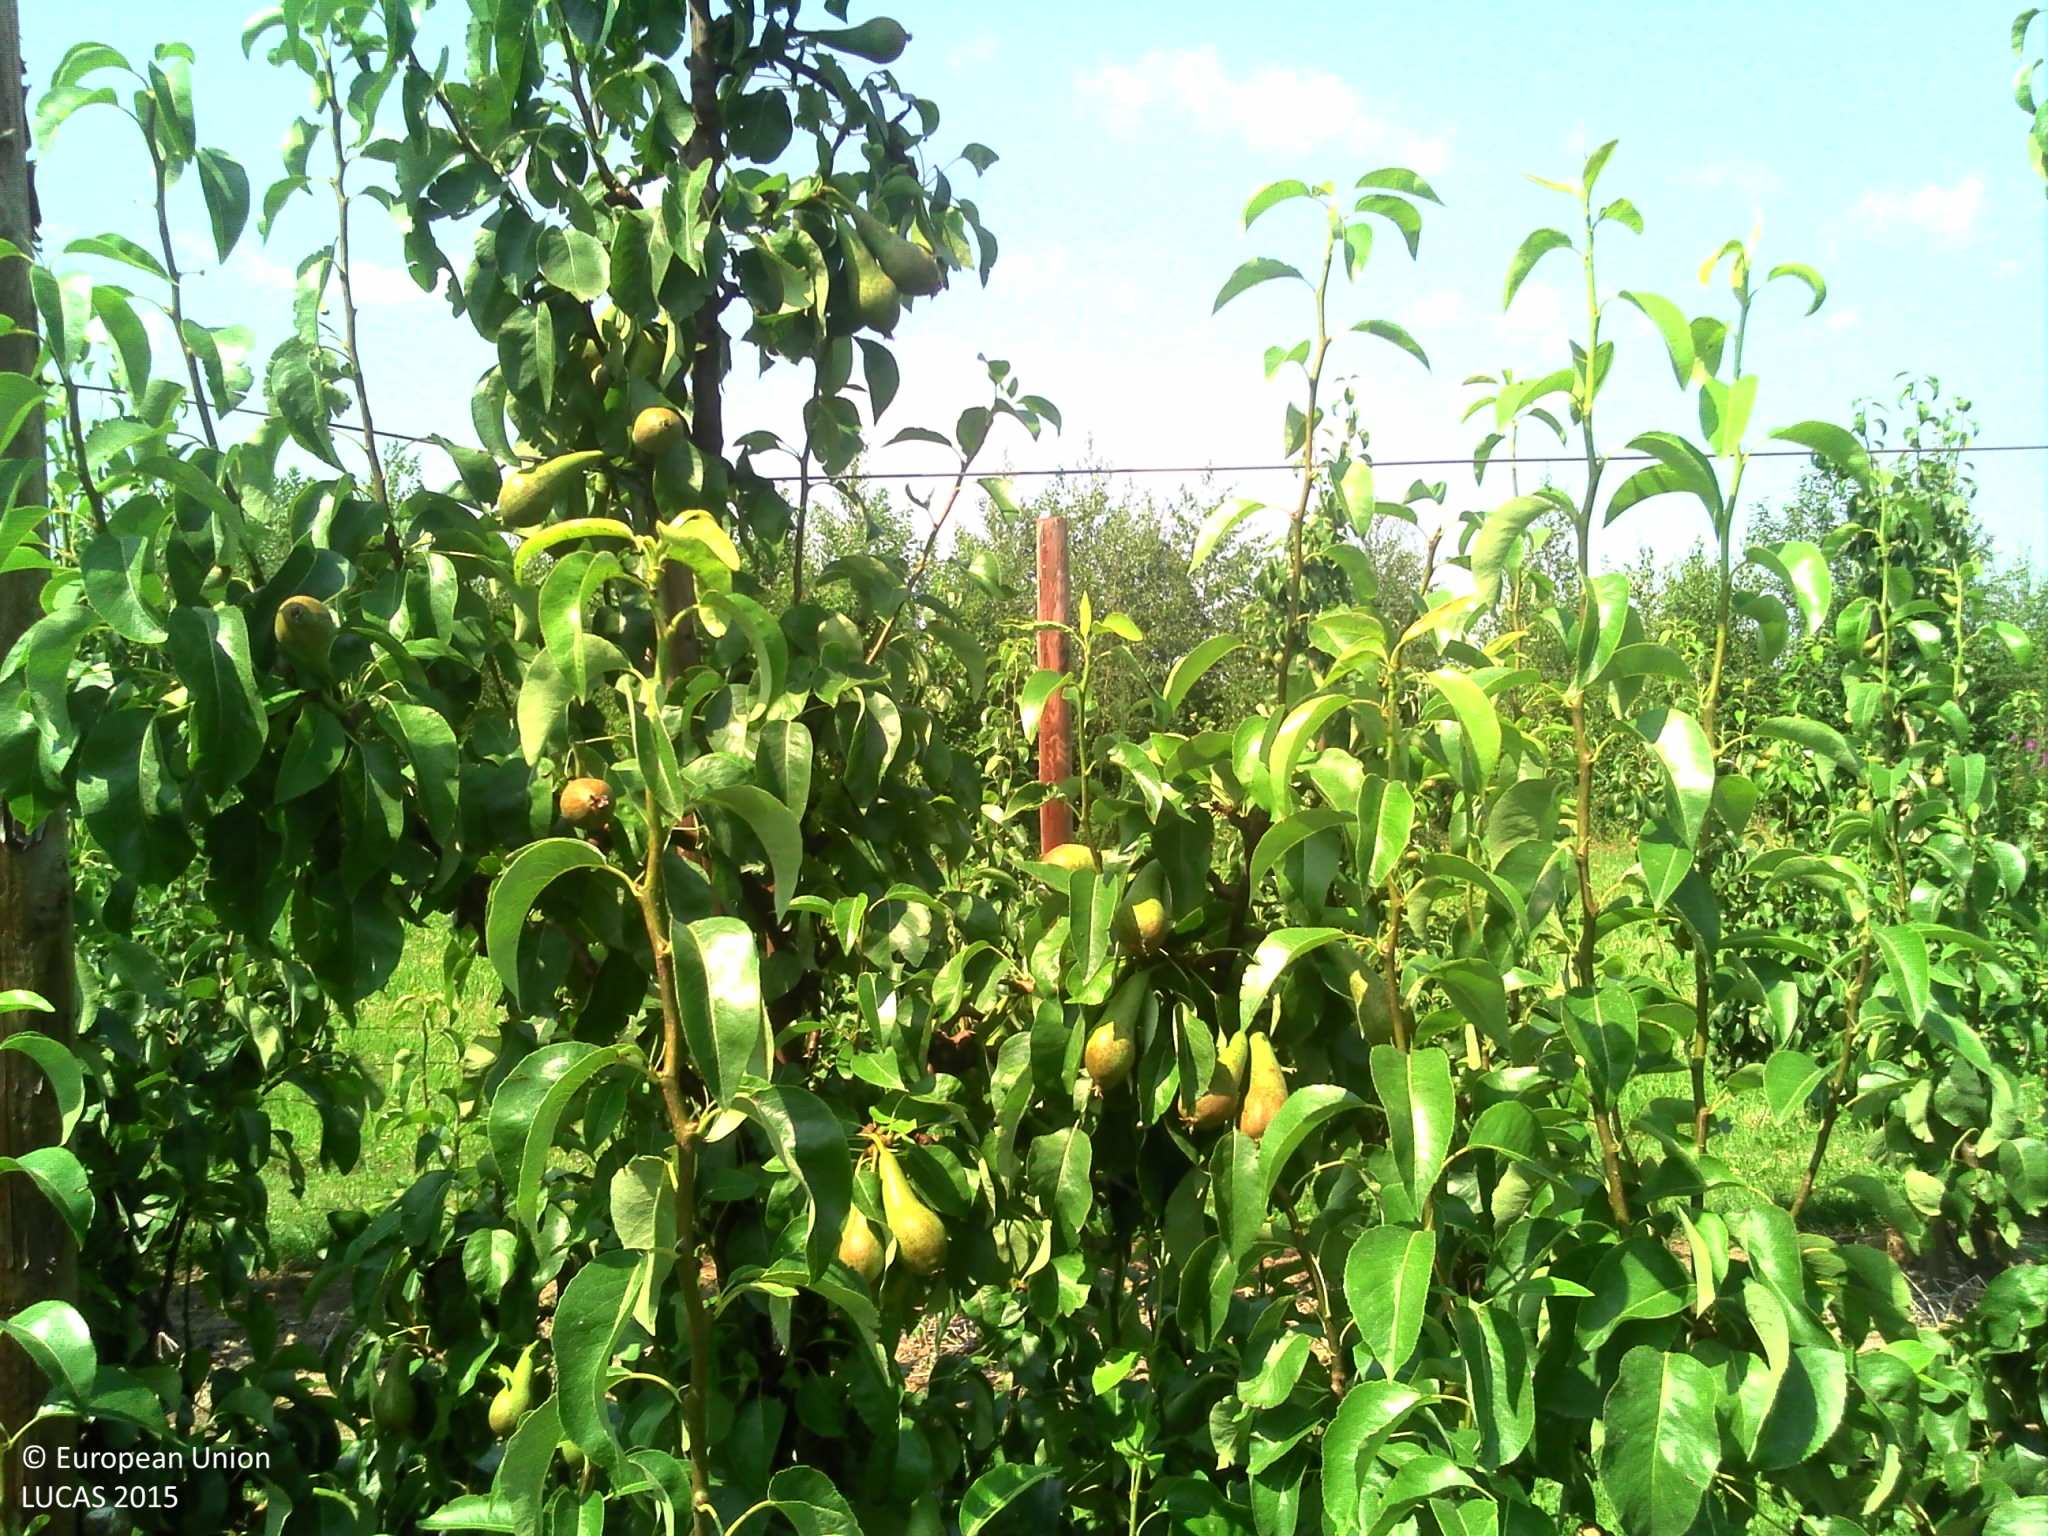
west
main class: Cropland
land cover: Pear fruit
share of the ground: > 75 %
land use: Agriculture (excluding fallow land and kitchen gardens)
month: July
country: BE
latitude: 50.9473
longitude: 4.7728
